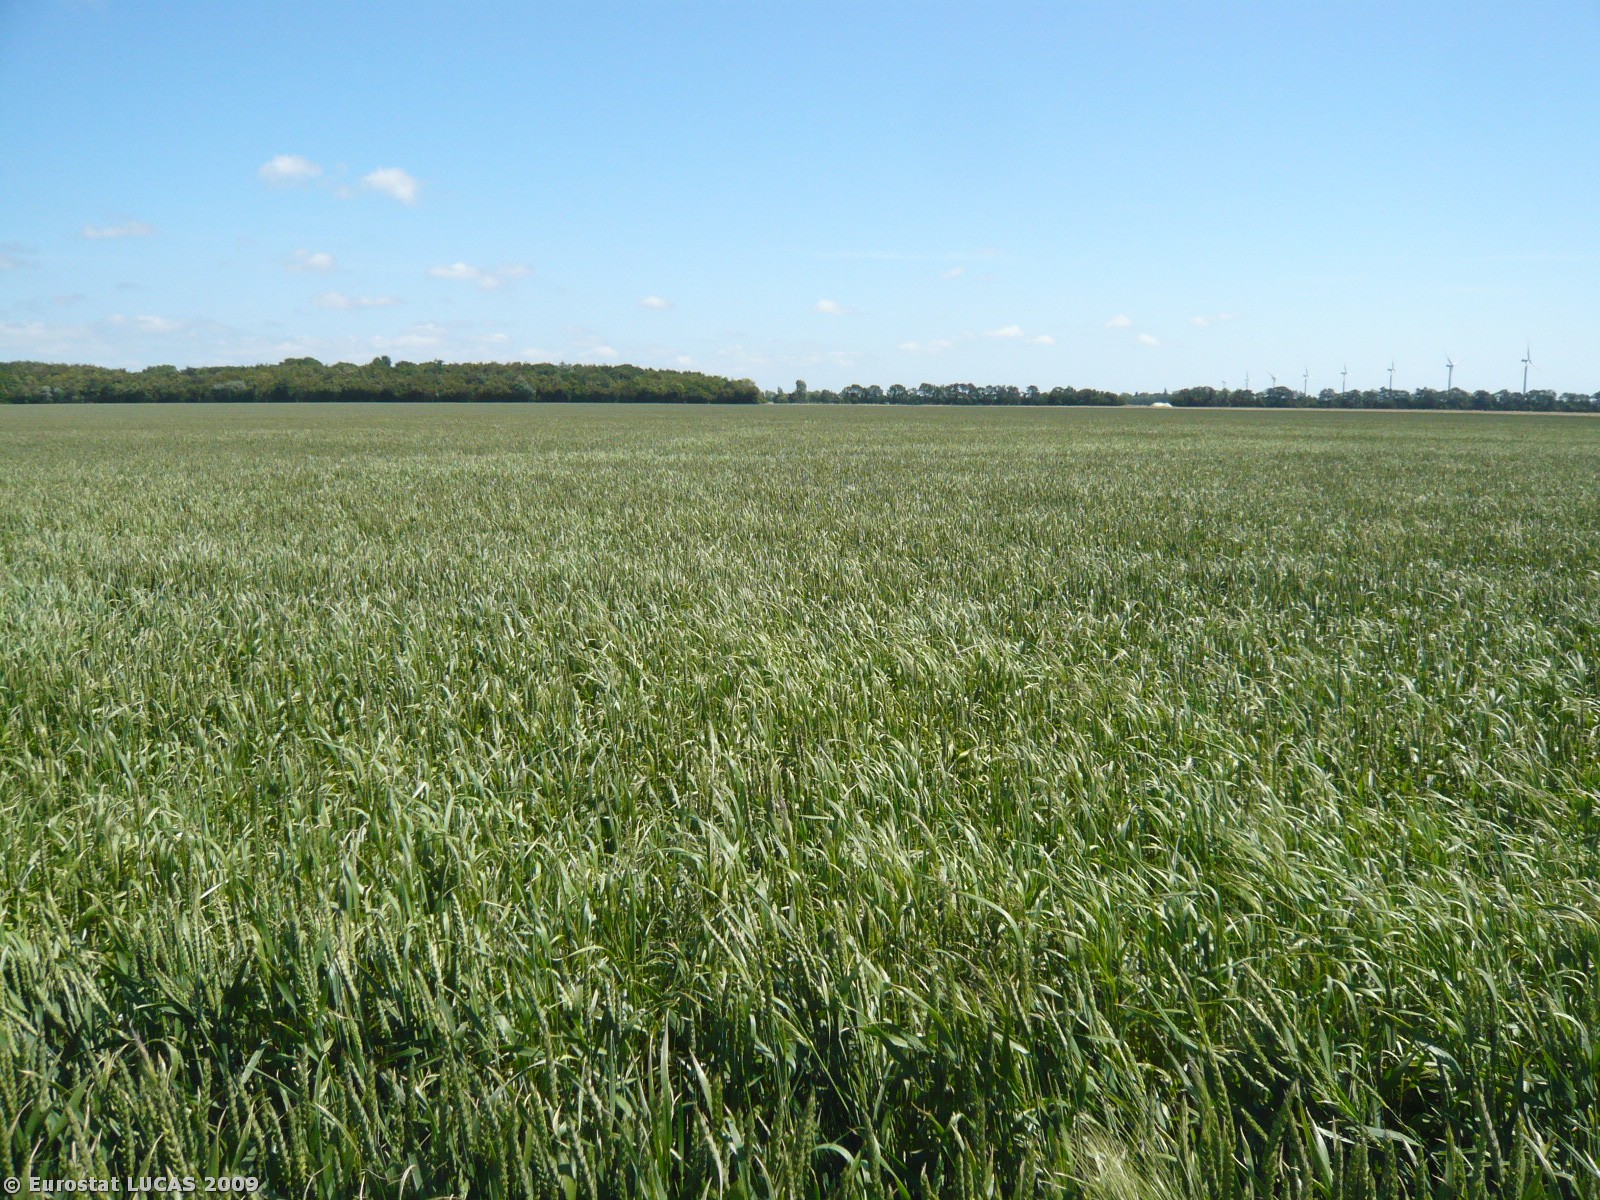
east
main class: Cropland
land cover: Common wheat
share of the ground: > 75 %
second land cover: Barley
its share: 10 - 25 %
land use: Agriculture (excluding fallow land and kitchen gardens)
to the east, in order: Common wheat; Grassland without tree/shrub cover; Inland running water; Grassland without tree/shrub cover; Grass margins; Common wheat
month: June
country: DK
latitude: 54.7252
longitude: 11.2879
